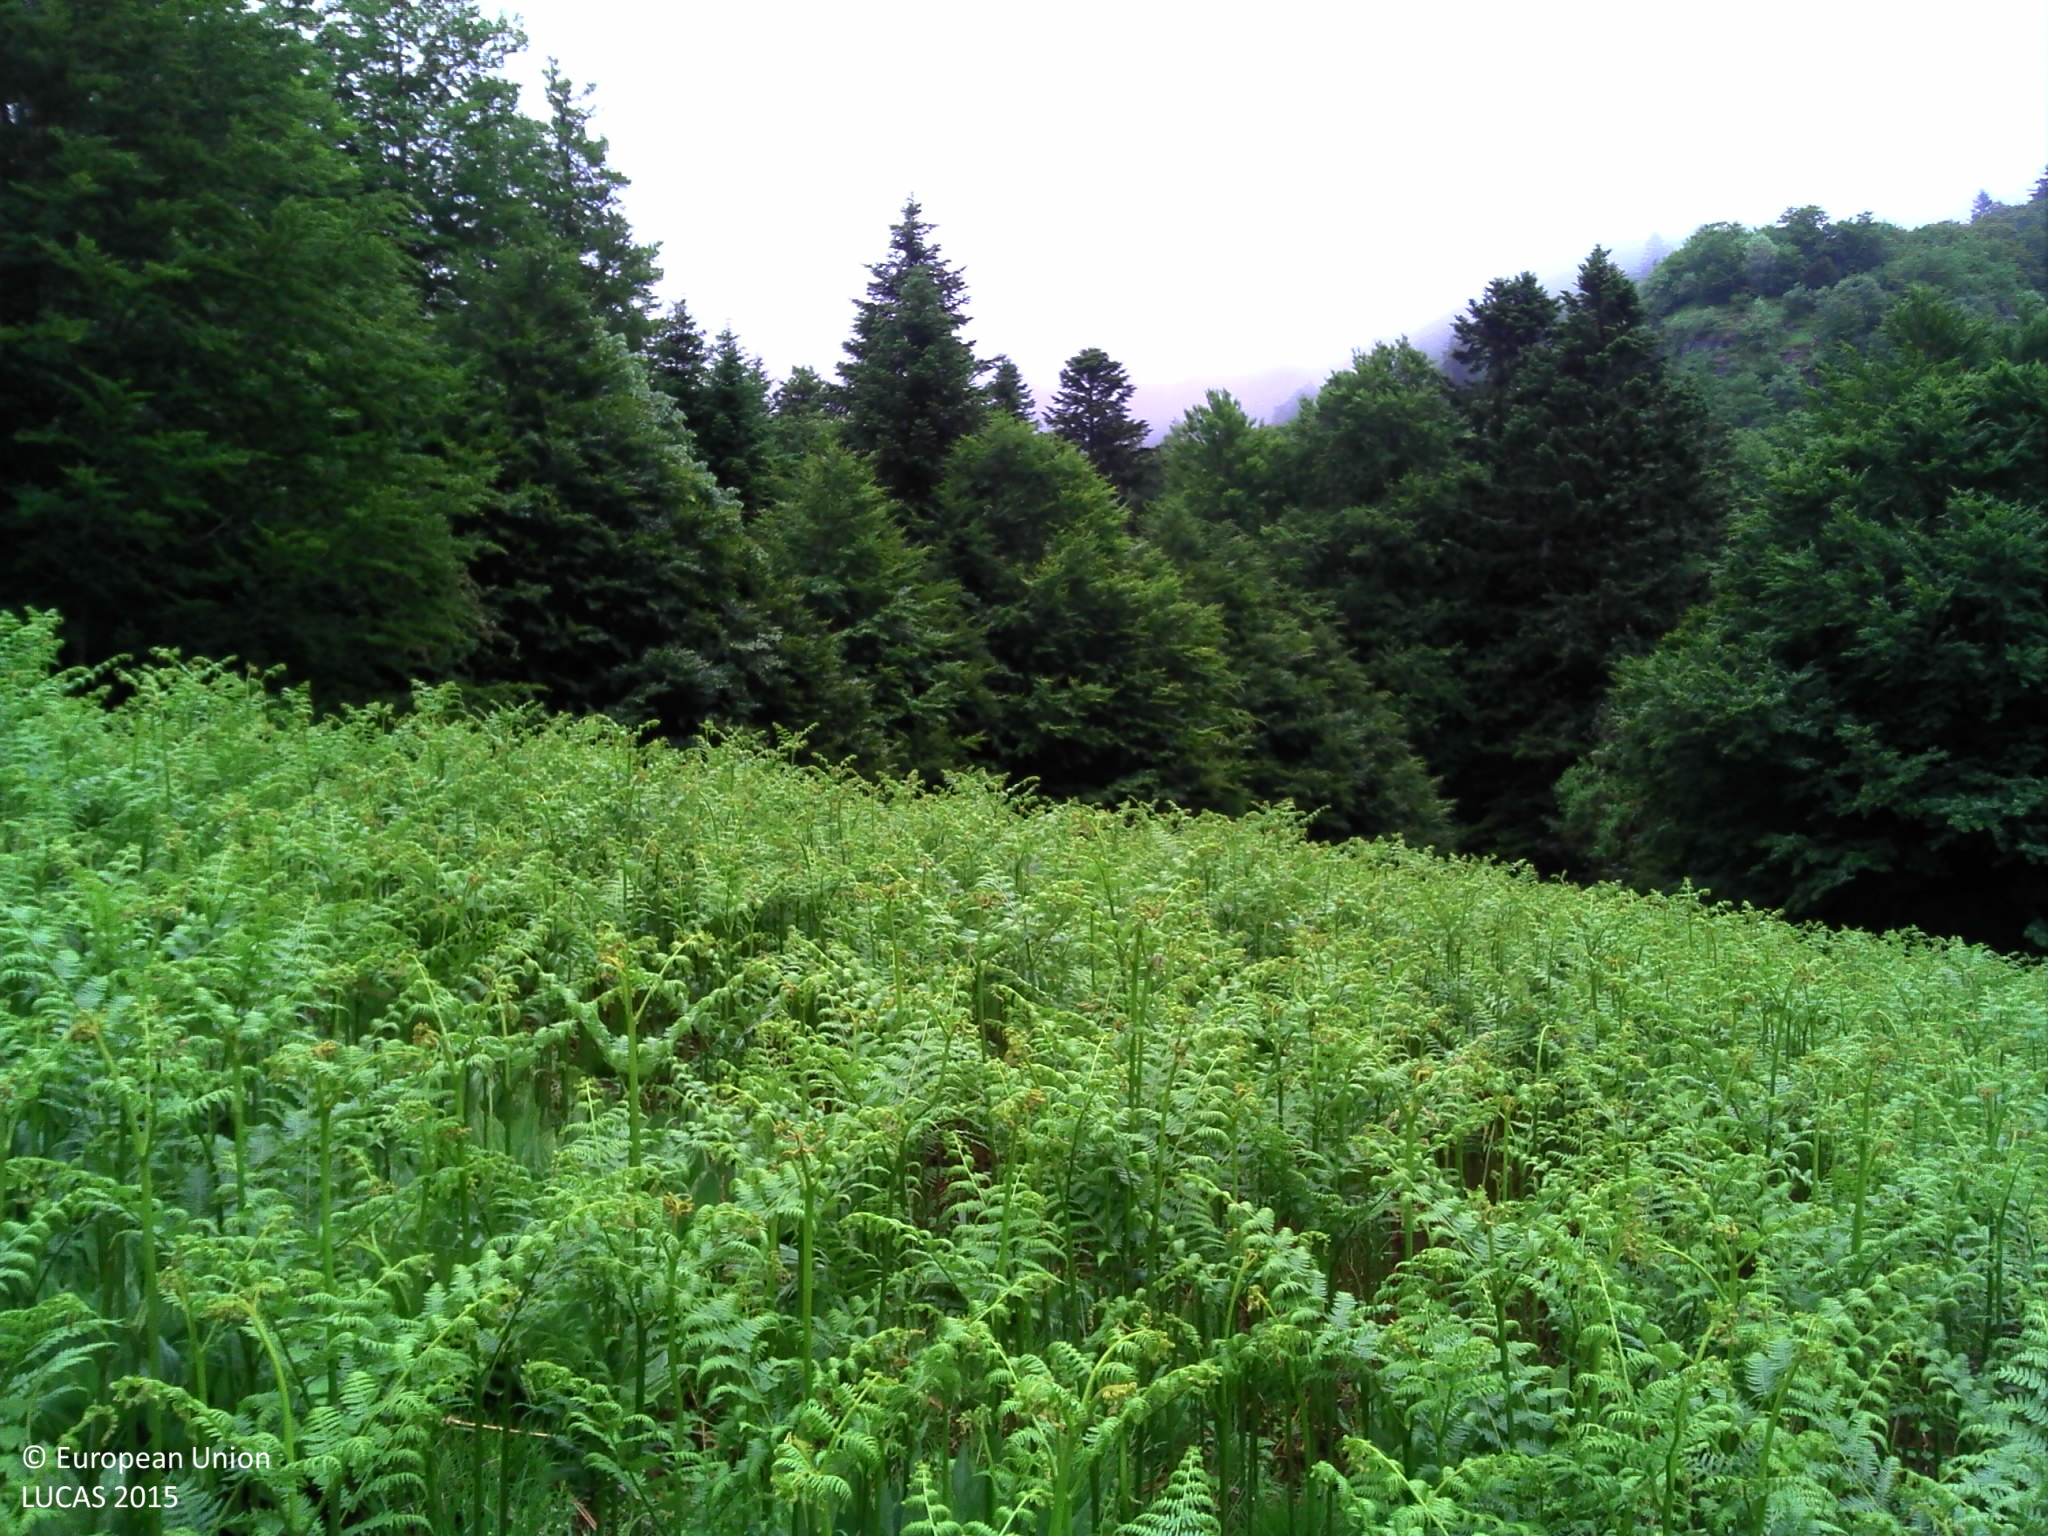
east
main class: Grassland
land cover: Grassland without tree/shrub cover
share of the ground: > 75 %
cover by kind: herbaceous plants 95 %, shrubs 5 %
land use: Agriculture (excluding fallow land and kitchen gardens)
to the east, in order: Grassland without tree/shrub cover; Spruce dominated mixed woodland; Spruce dominated coniferous woodland; Spruce dominated mixed woodland; Rock outcrops; Inland fresh running water; Rock outcrops; Dry stone walls; Paved roads, cycling and walking lanes; Dry stone walls; Grass margins; Broadleaved woodland; Rock outcrops; Spruce dominated mixed woodland
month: June
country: FR
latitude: 42.8103
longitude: -0.5585
